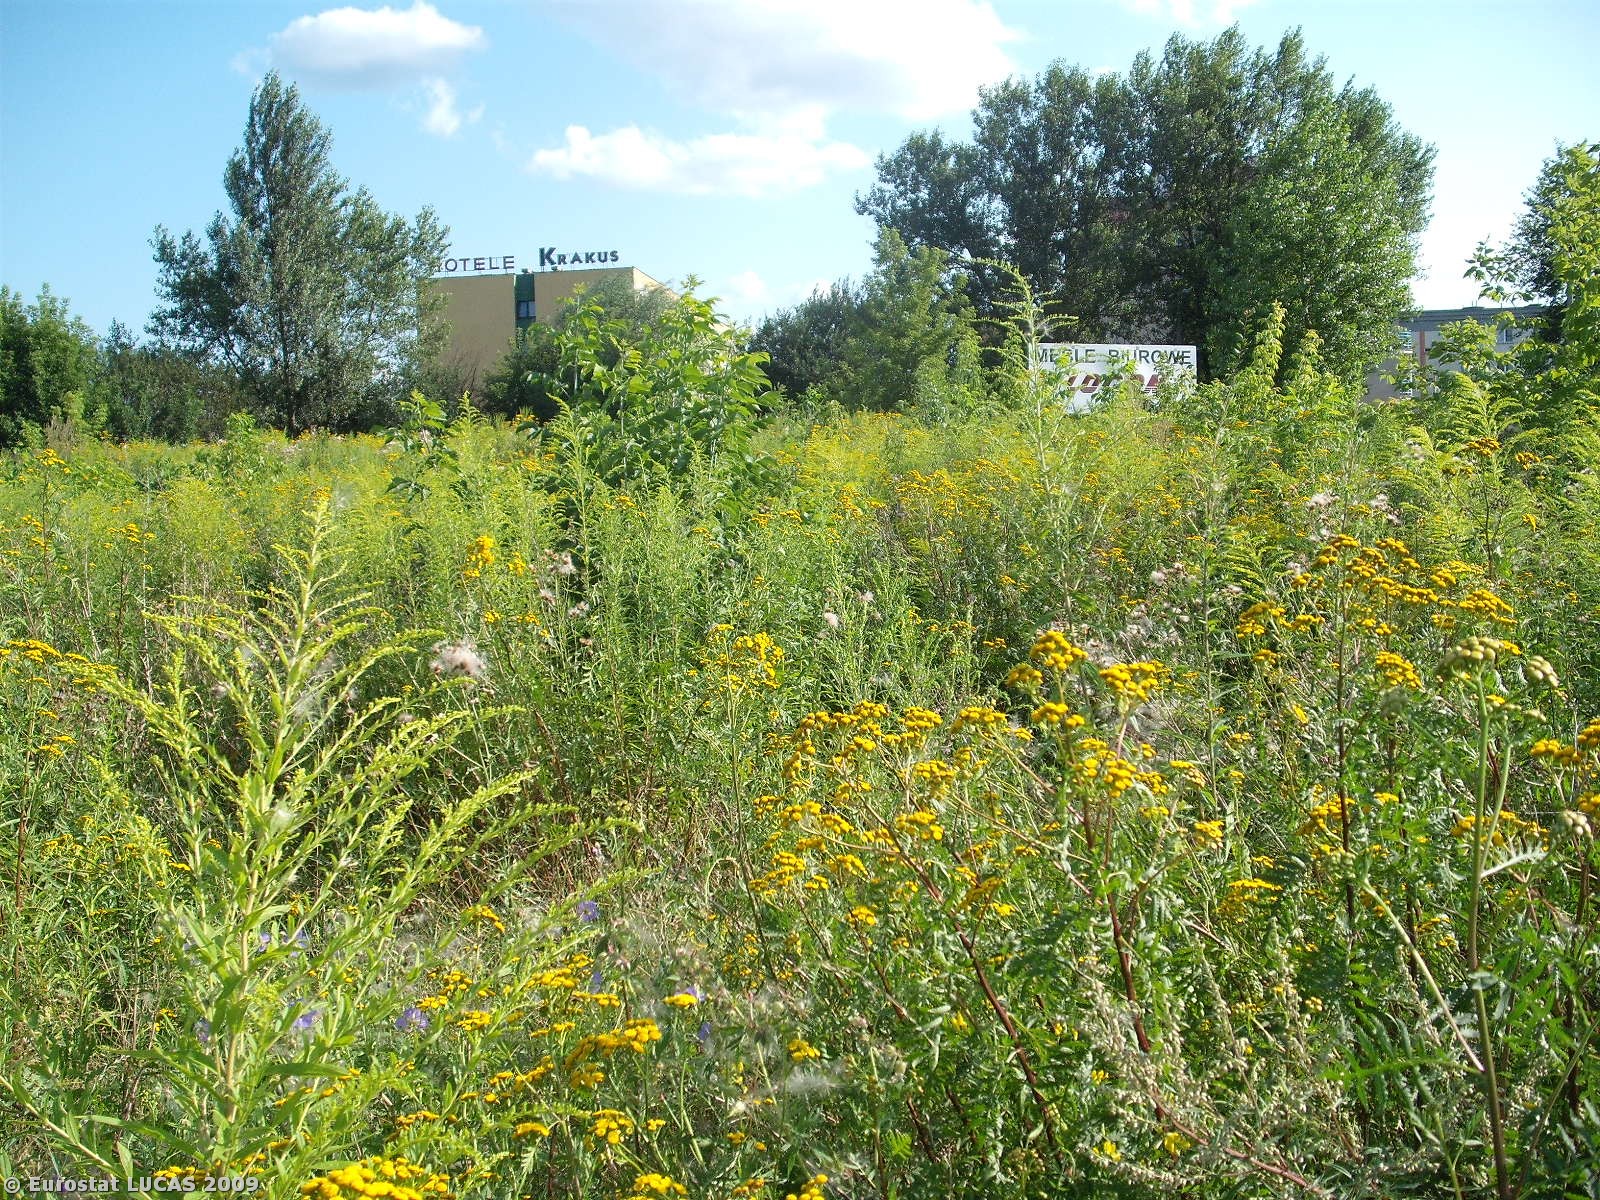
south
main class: Grassland
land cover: Spontaneously vegetated surfaces
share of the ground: > 75 %
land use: Unused
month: August
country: PL
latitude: 50.0525
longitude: 19.9901
